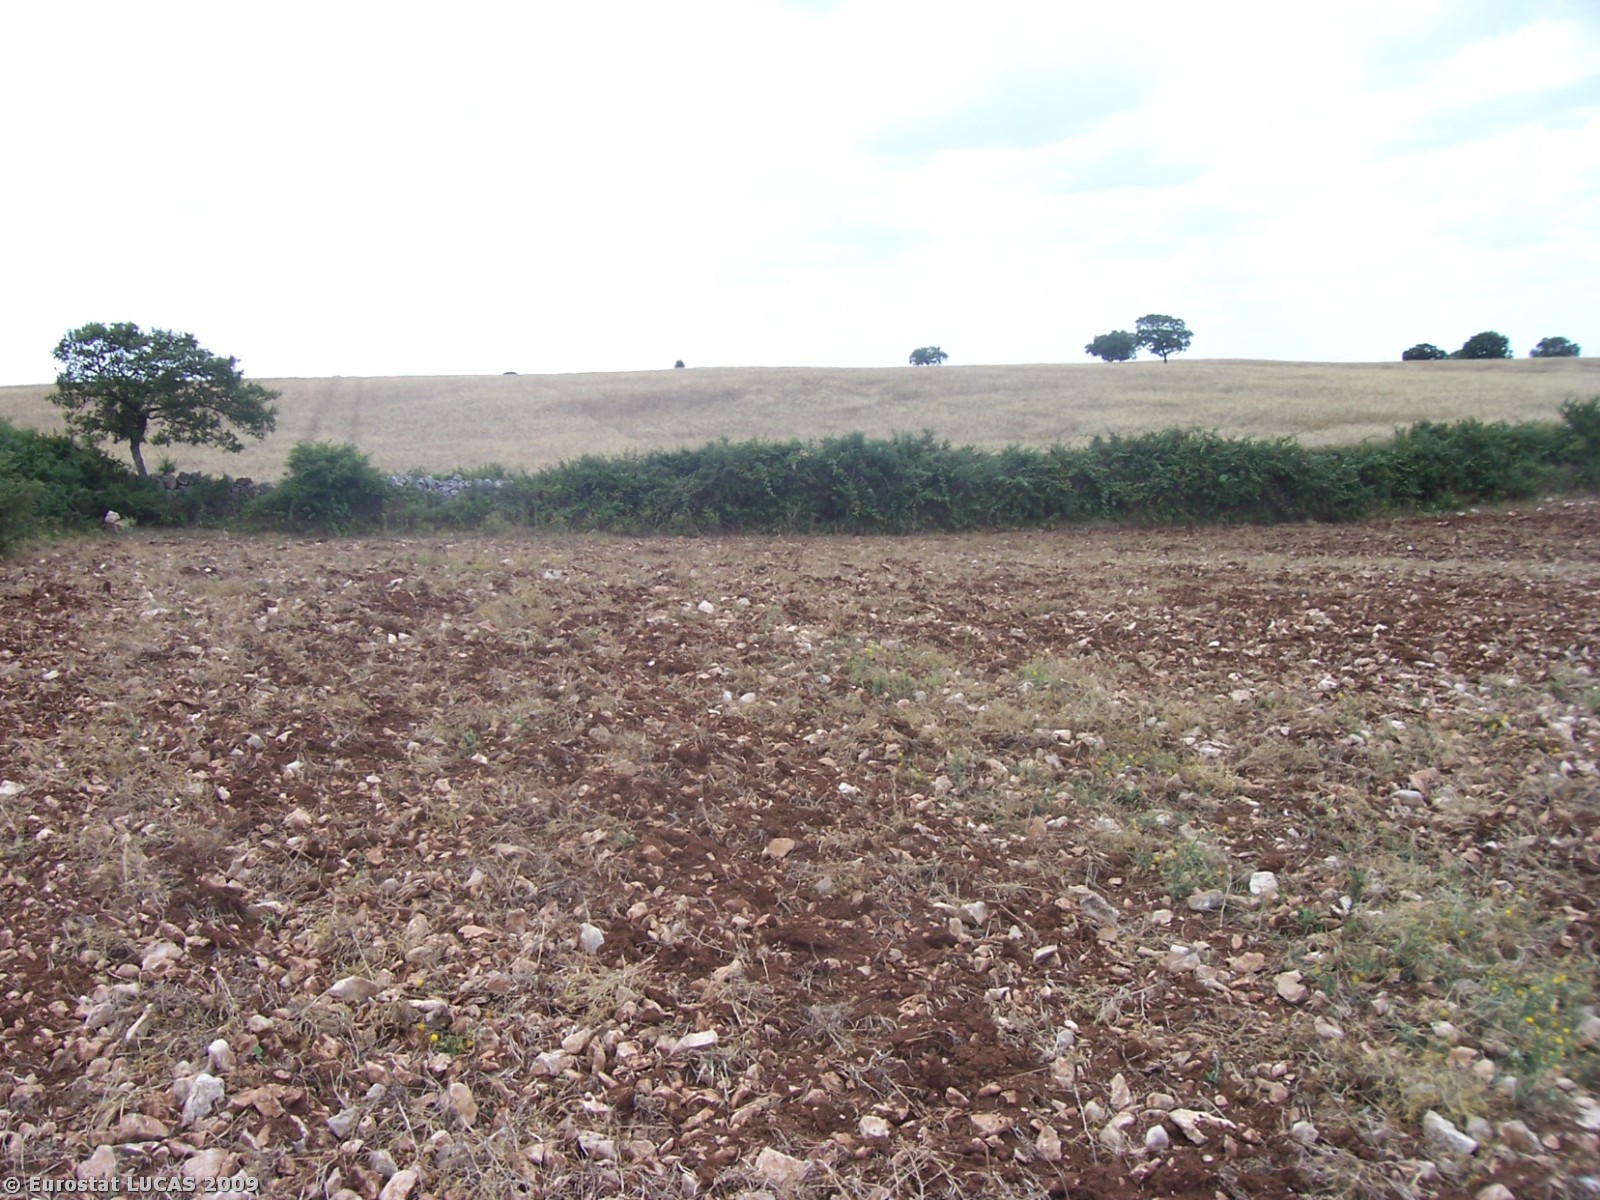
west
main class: Cropland
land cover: Temporary grasslands
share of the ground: < 10 %
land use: Agriculture (excluding fallow land and kitchen gardens)
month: July
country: IT
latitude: 40.7776
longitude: 17.0274
